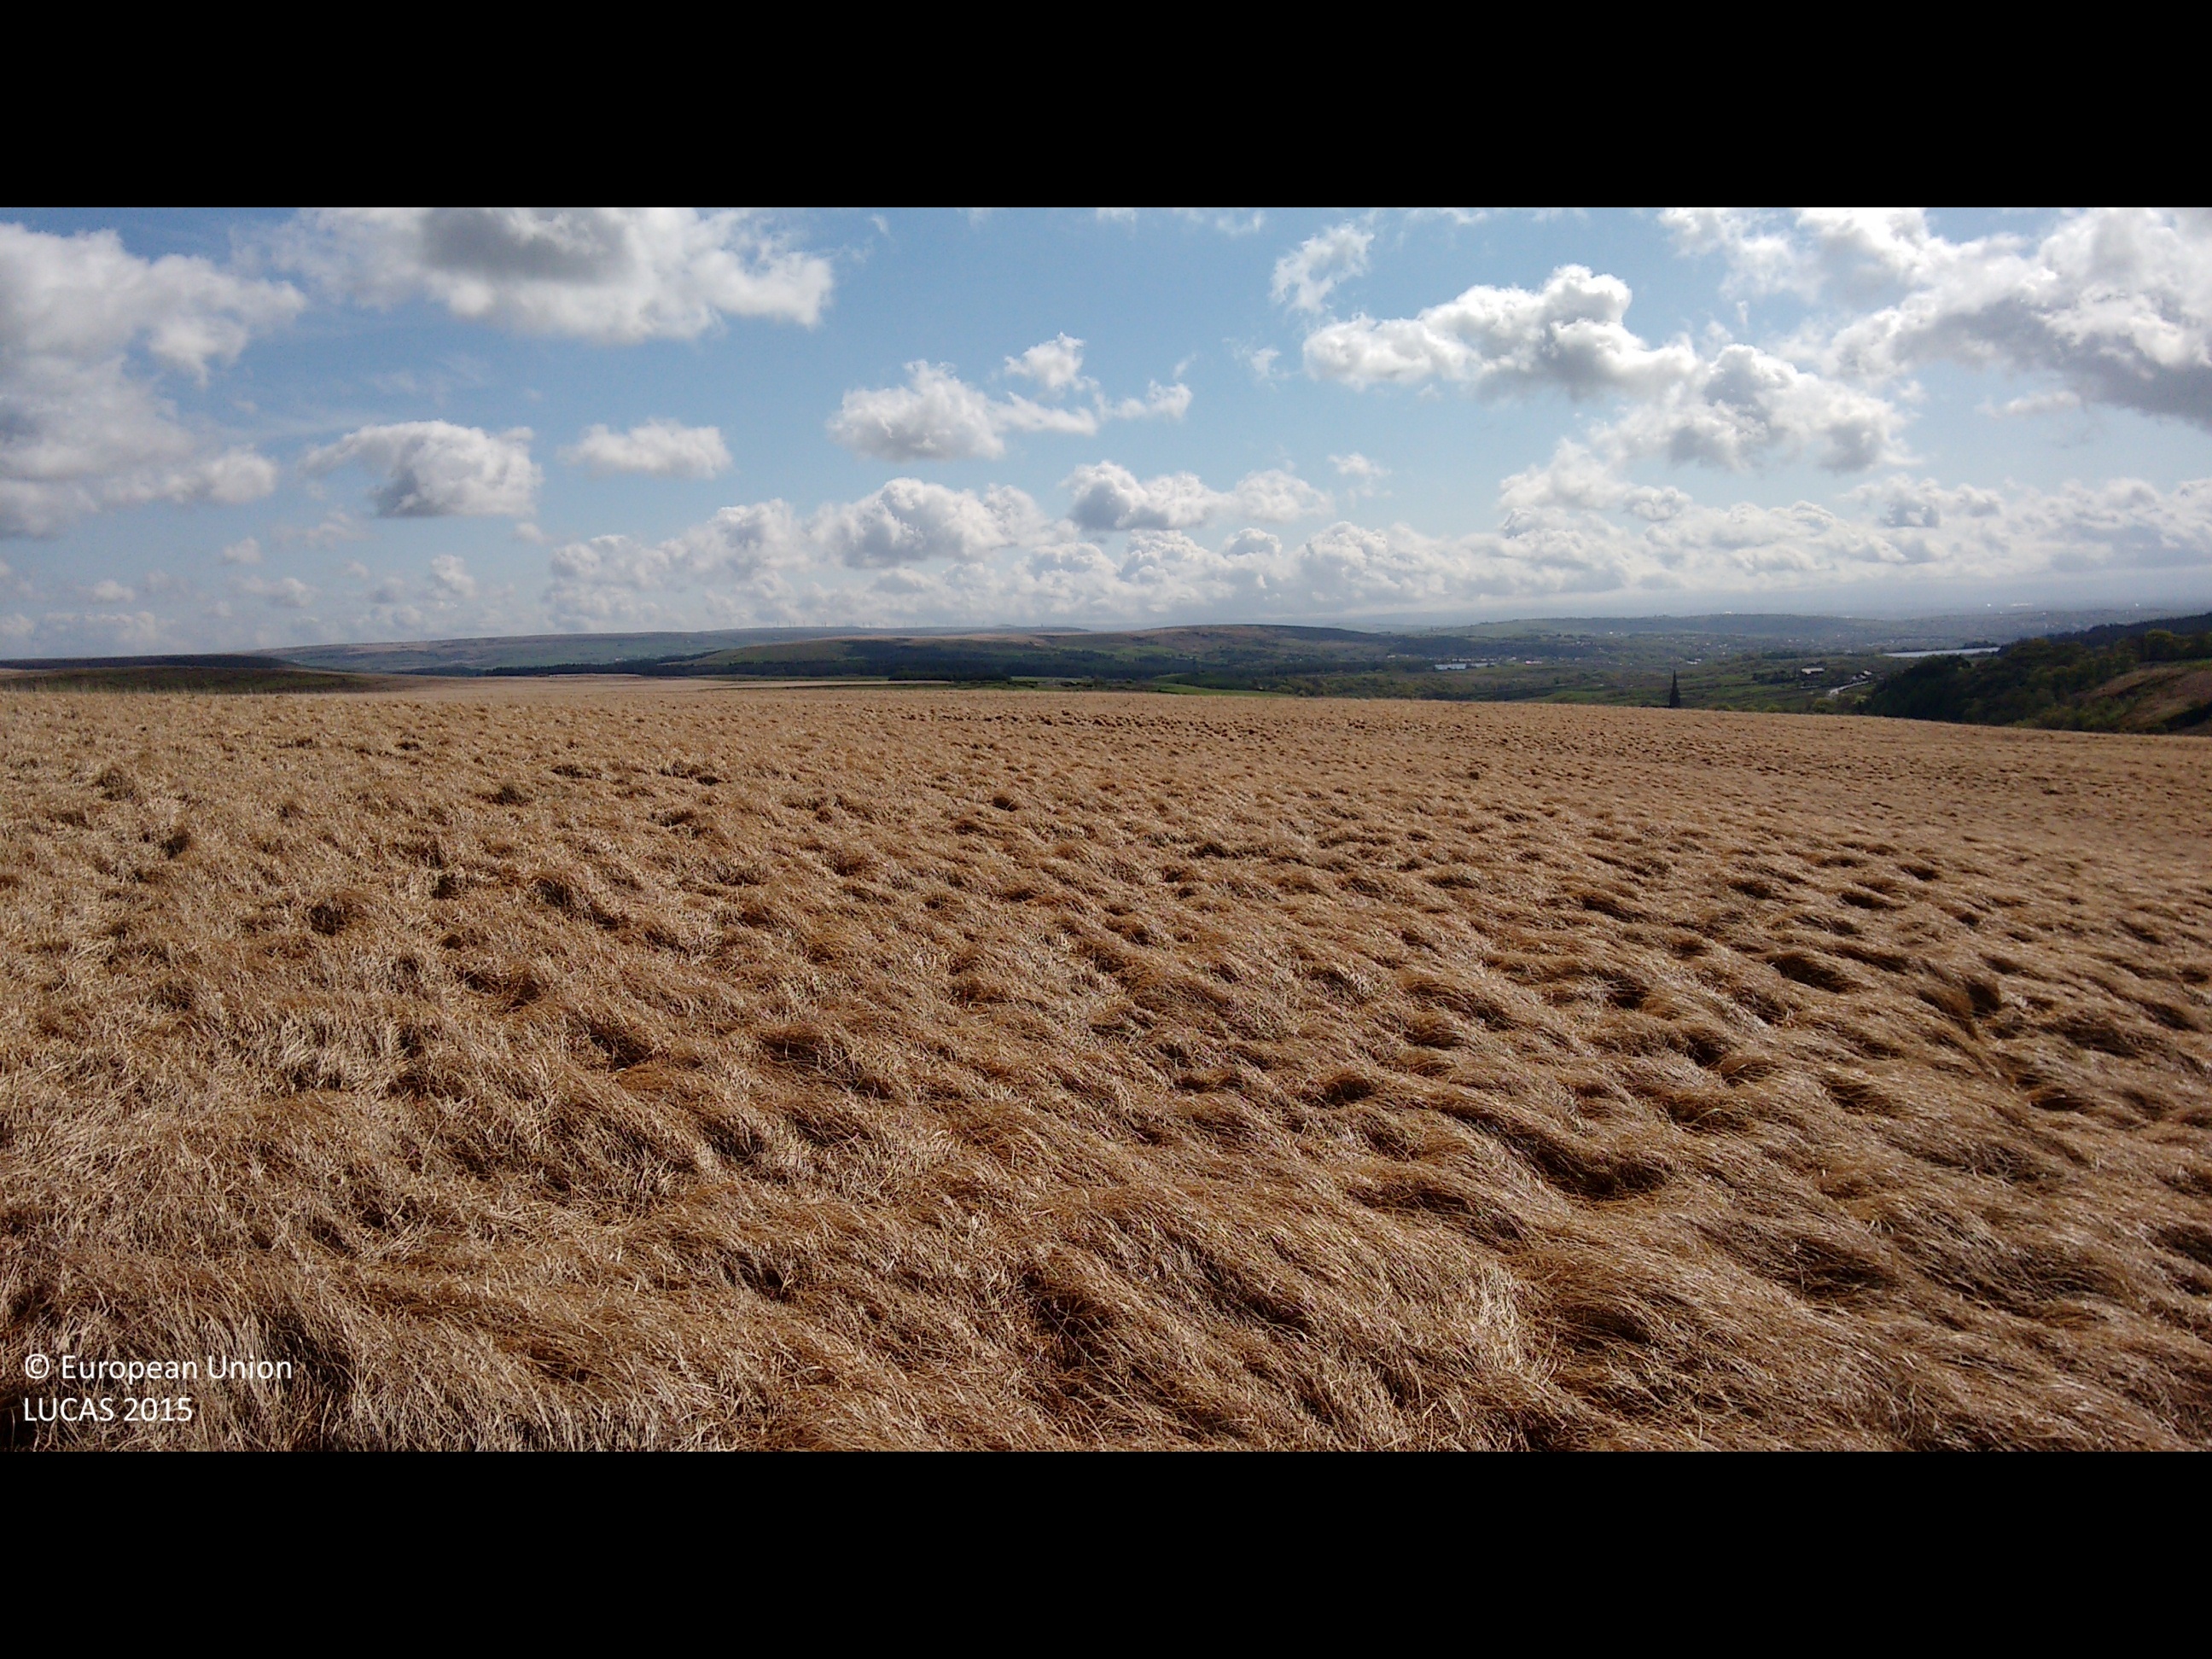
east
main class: Grassland
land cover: Grassland without tree/shrub cover
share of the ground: > 75 %
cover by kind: herbaceous plants 100 %
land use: Agriculture (excluding fallow land and kitchen gardens)
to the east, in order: Grassland without tree/shrub cover
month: May
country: GB
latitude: 53.6416
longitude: -2.5142
